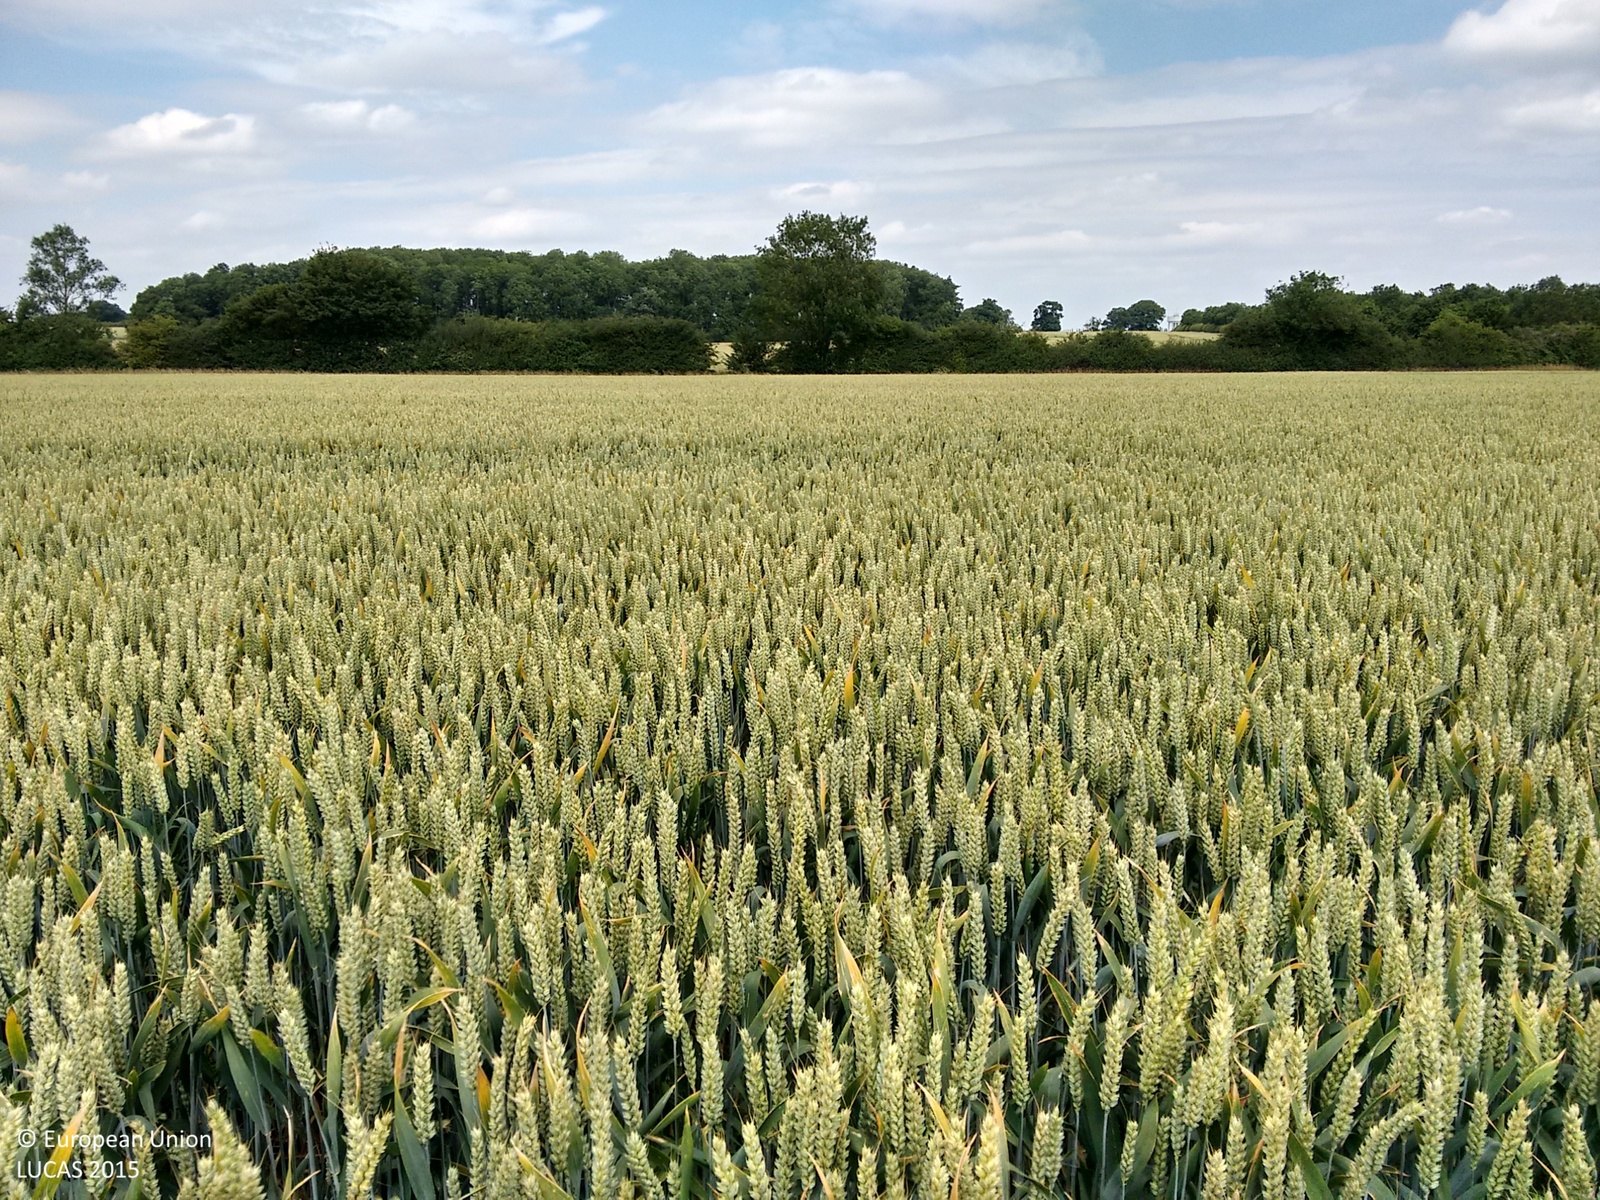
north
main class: Cropland
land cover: Common wheat
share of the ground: > 75 %
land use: Agriculture (excluding fallow land and kitchen gardens)
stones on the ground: < 10 %
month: July
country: GB
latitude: 52.4690
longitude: -0.7427
